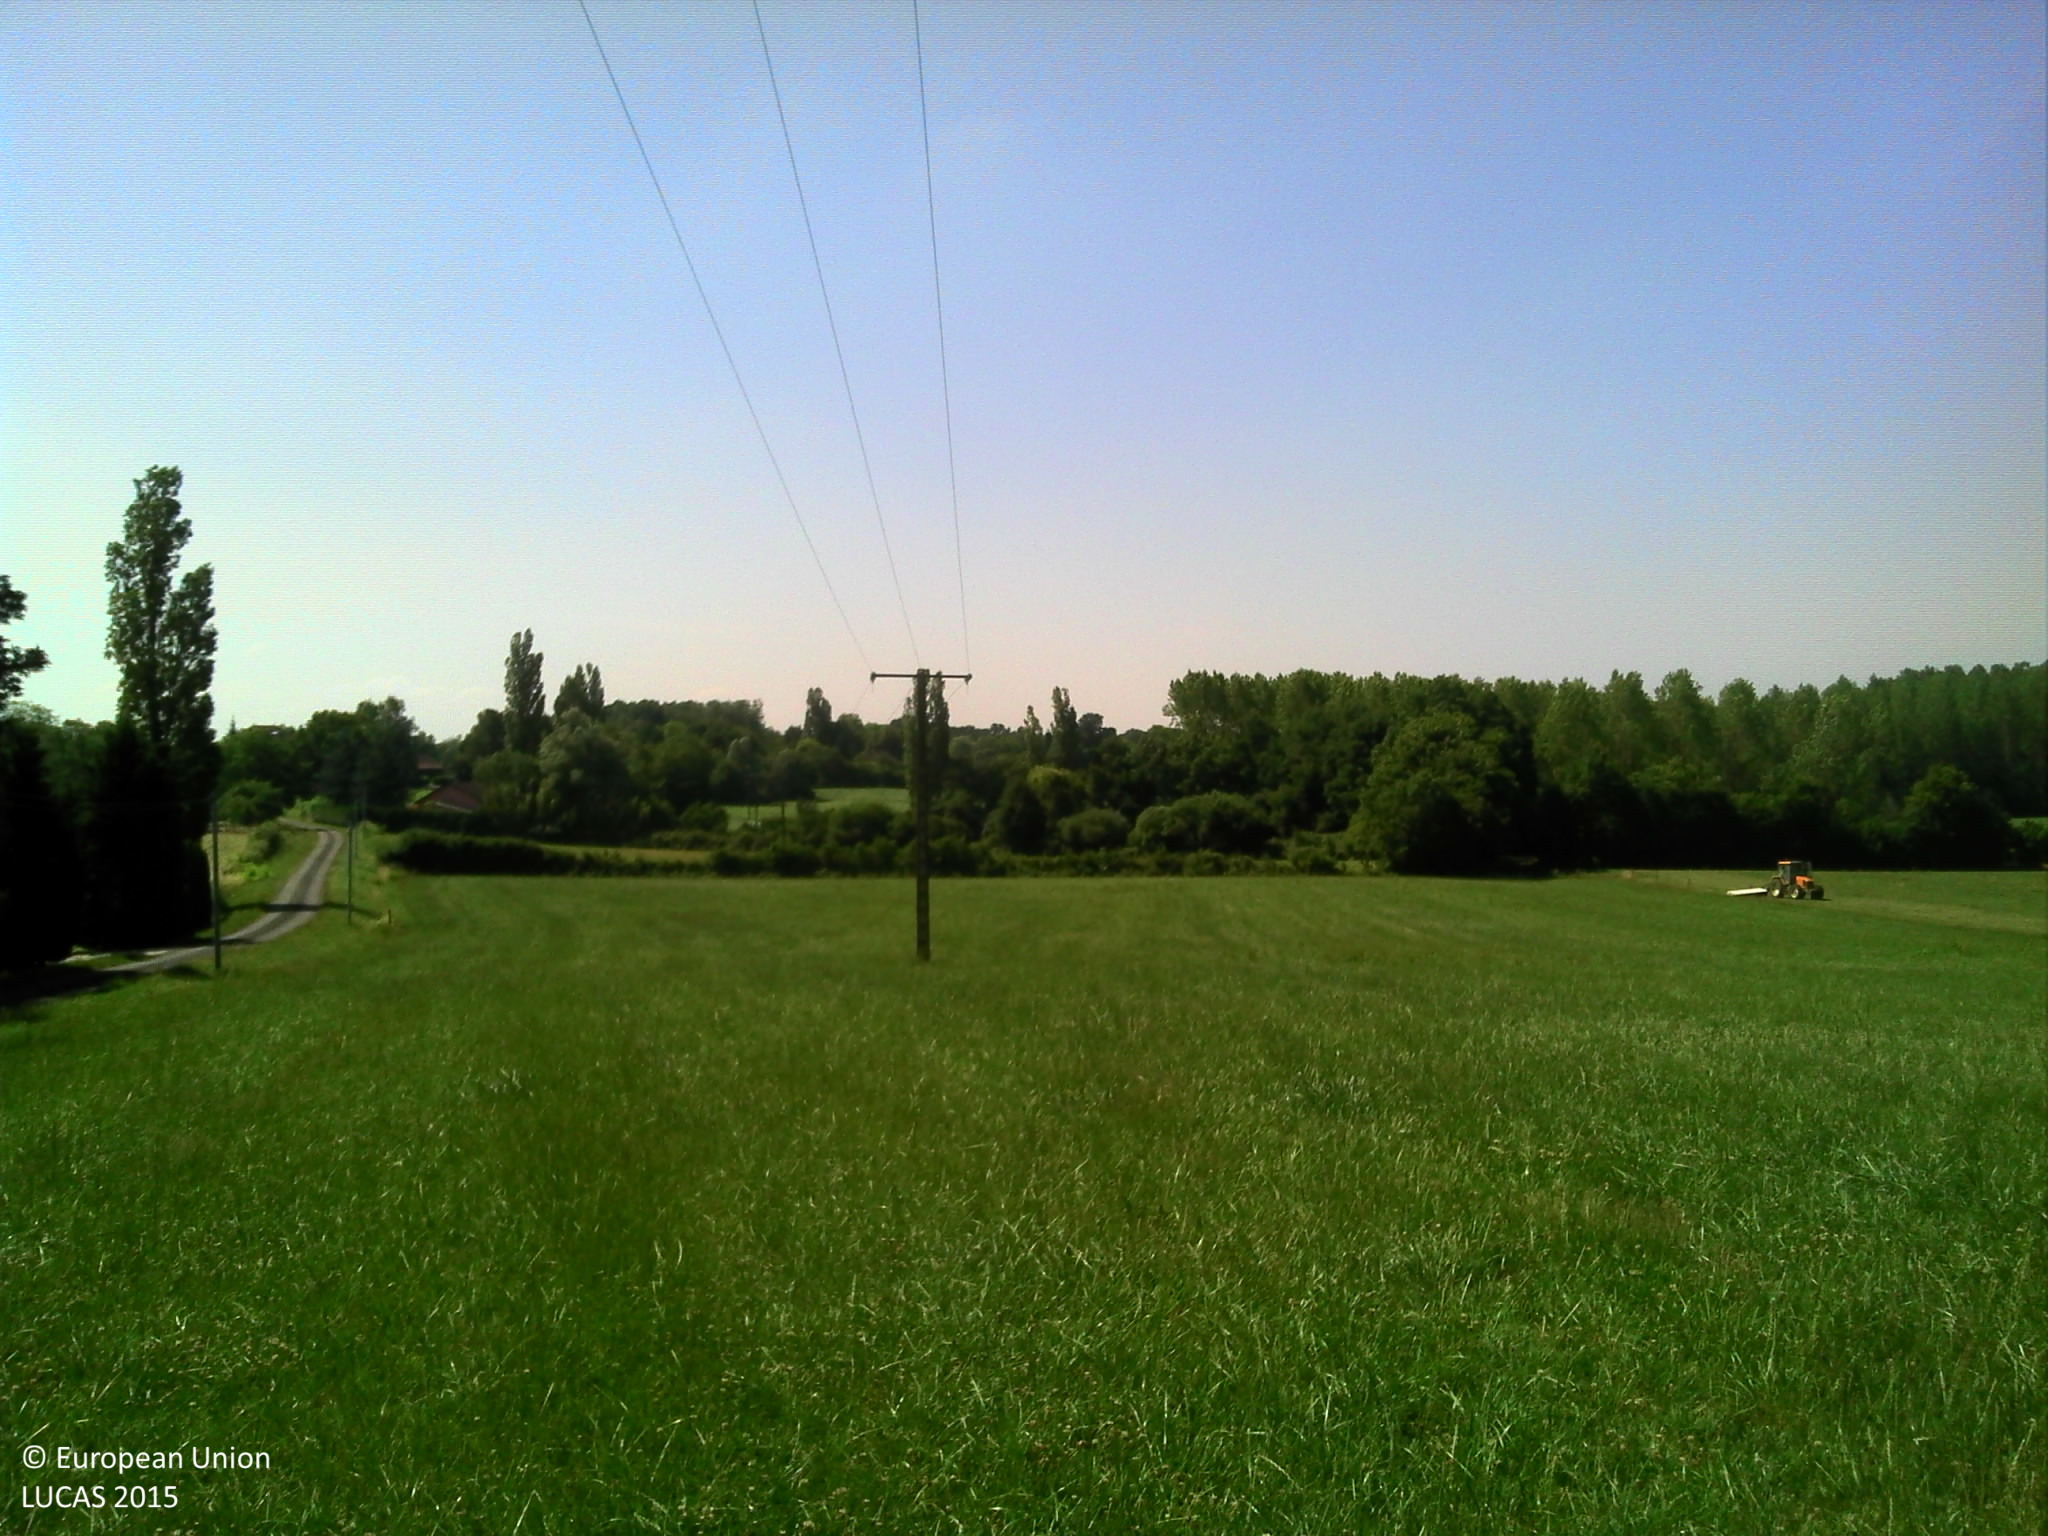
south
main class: Cropland
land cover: Clovers
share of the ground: > 75 %
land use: Agriculture (excluding fallow land and kitchen gardens)
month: June
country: FR
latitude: 46.7902
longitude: 5.3252
